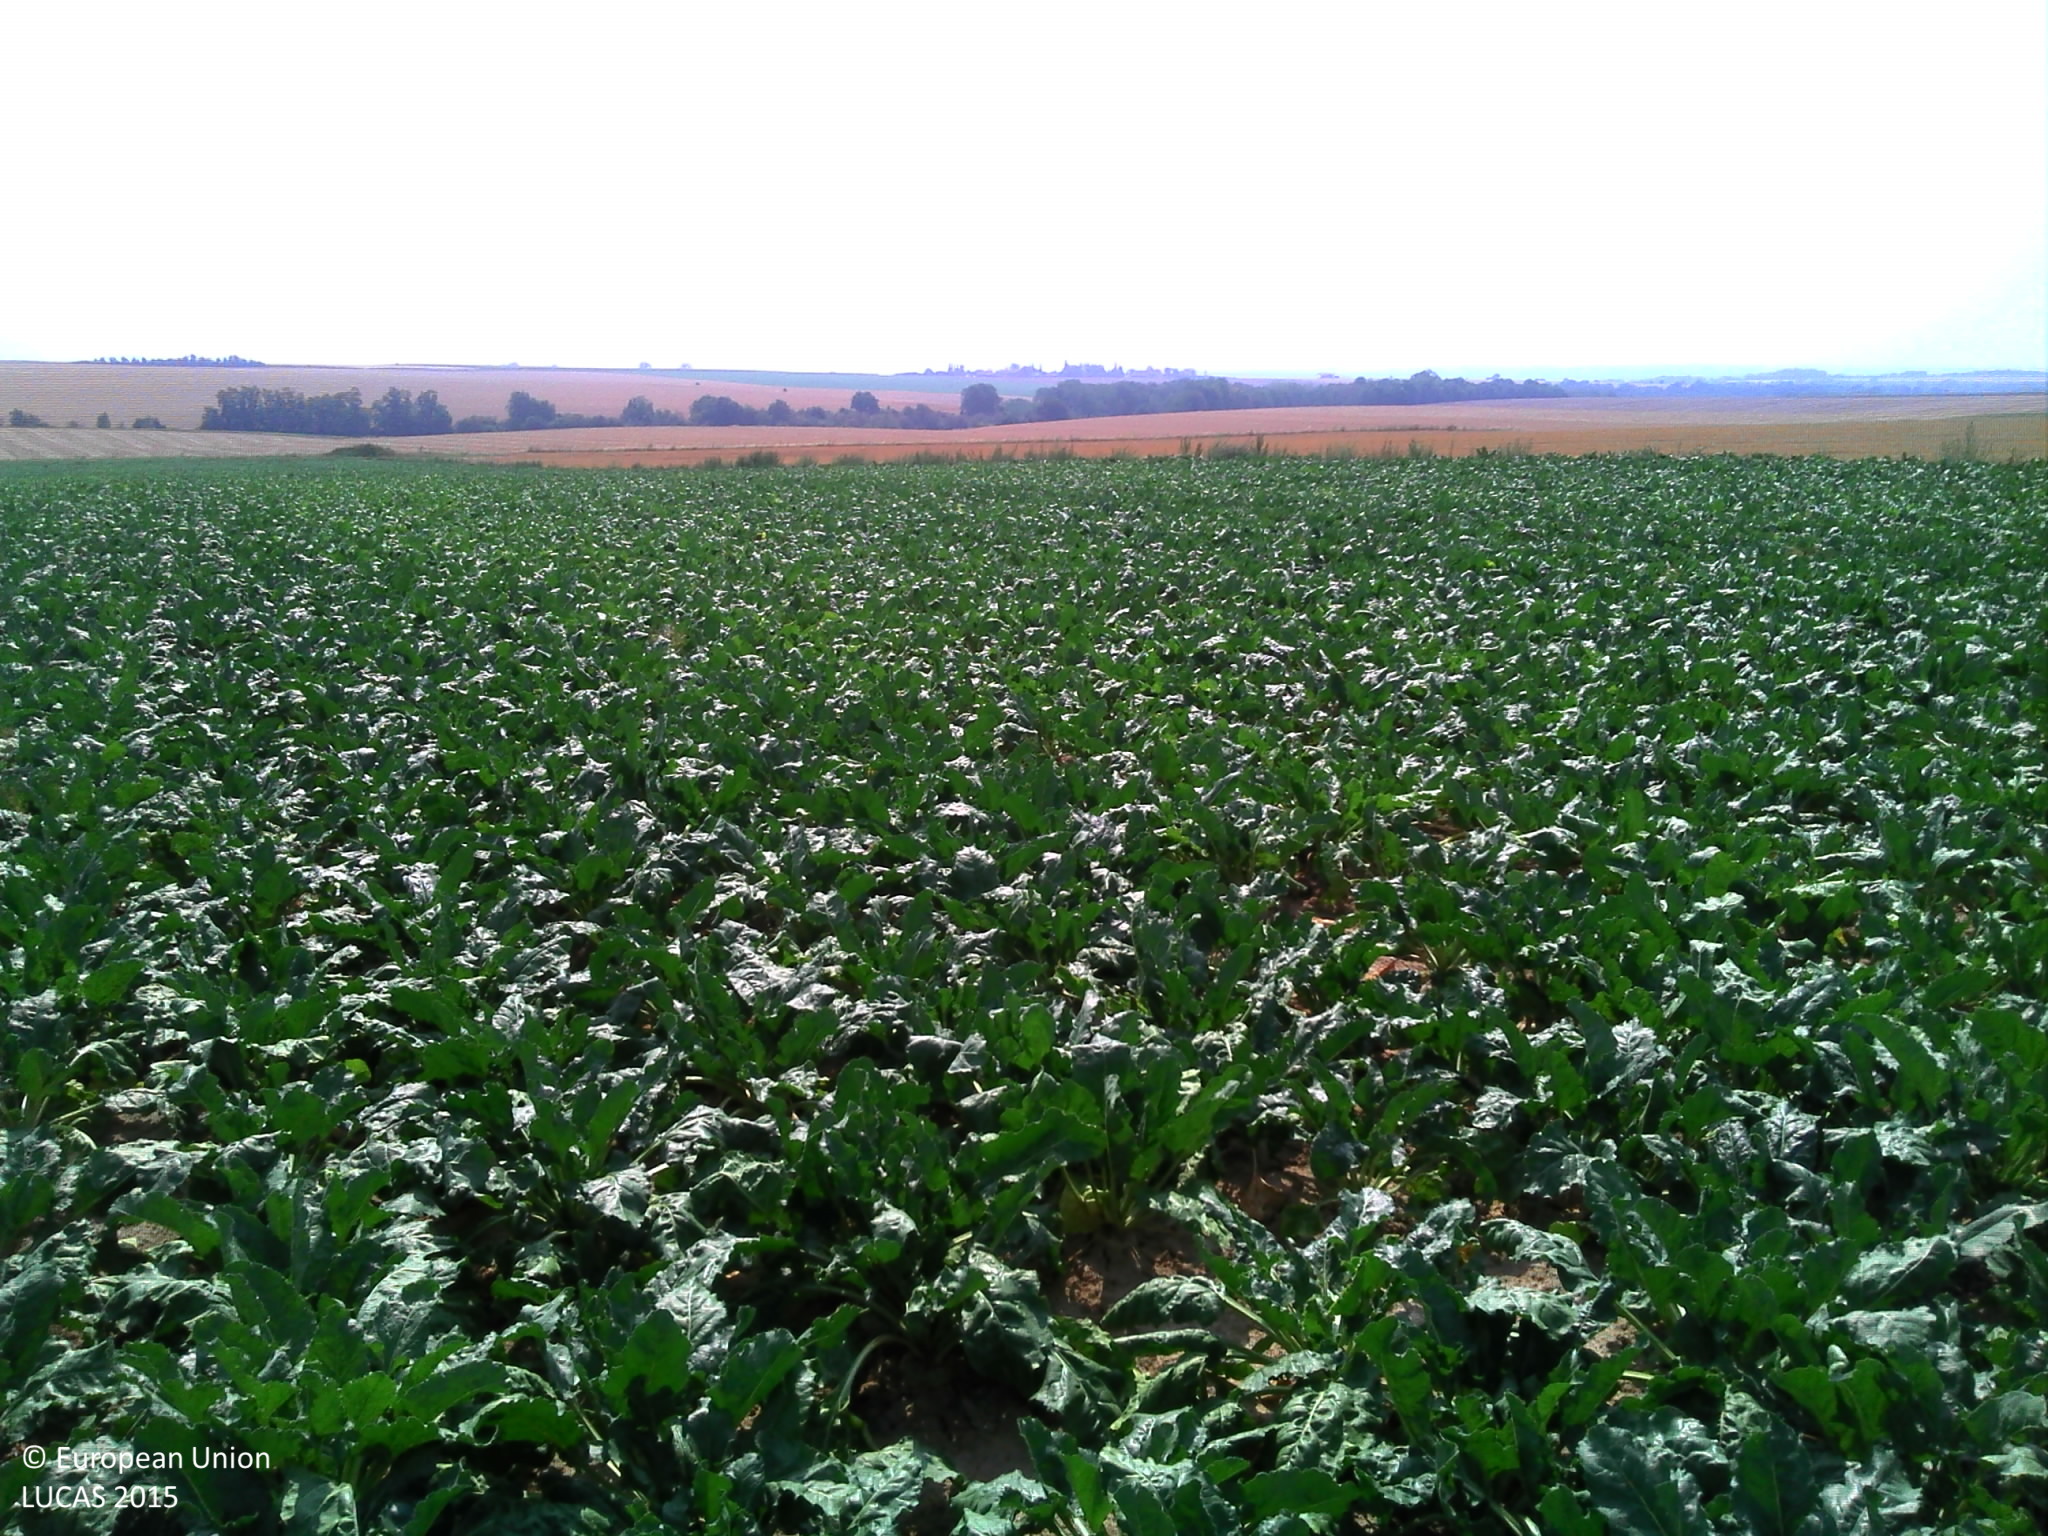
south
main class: Cropland
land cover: Sugar beet
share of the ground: > 75 %
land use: Agriculture (excluding fallow land and kitchen gardens)
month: August
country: FR
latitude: 49.0628
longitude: 2.9424
